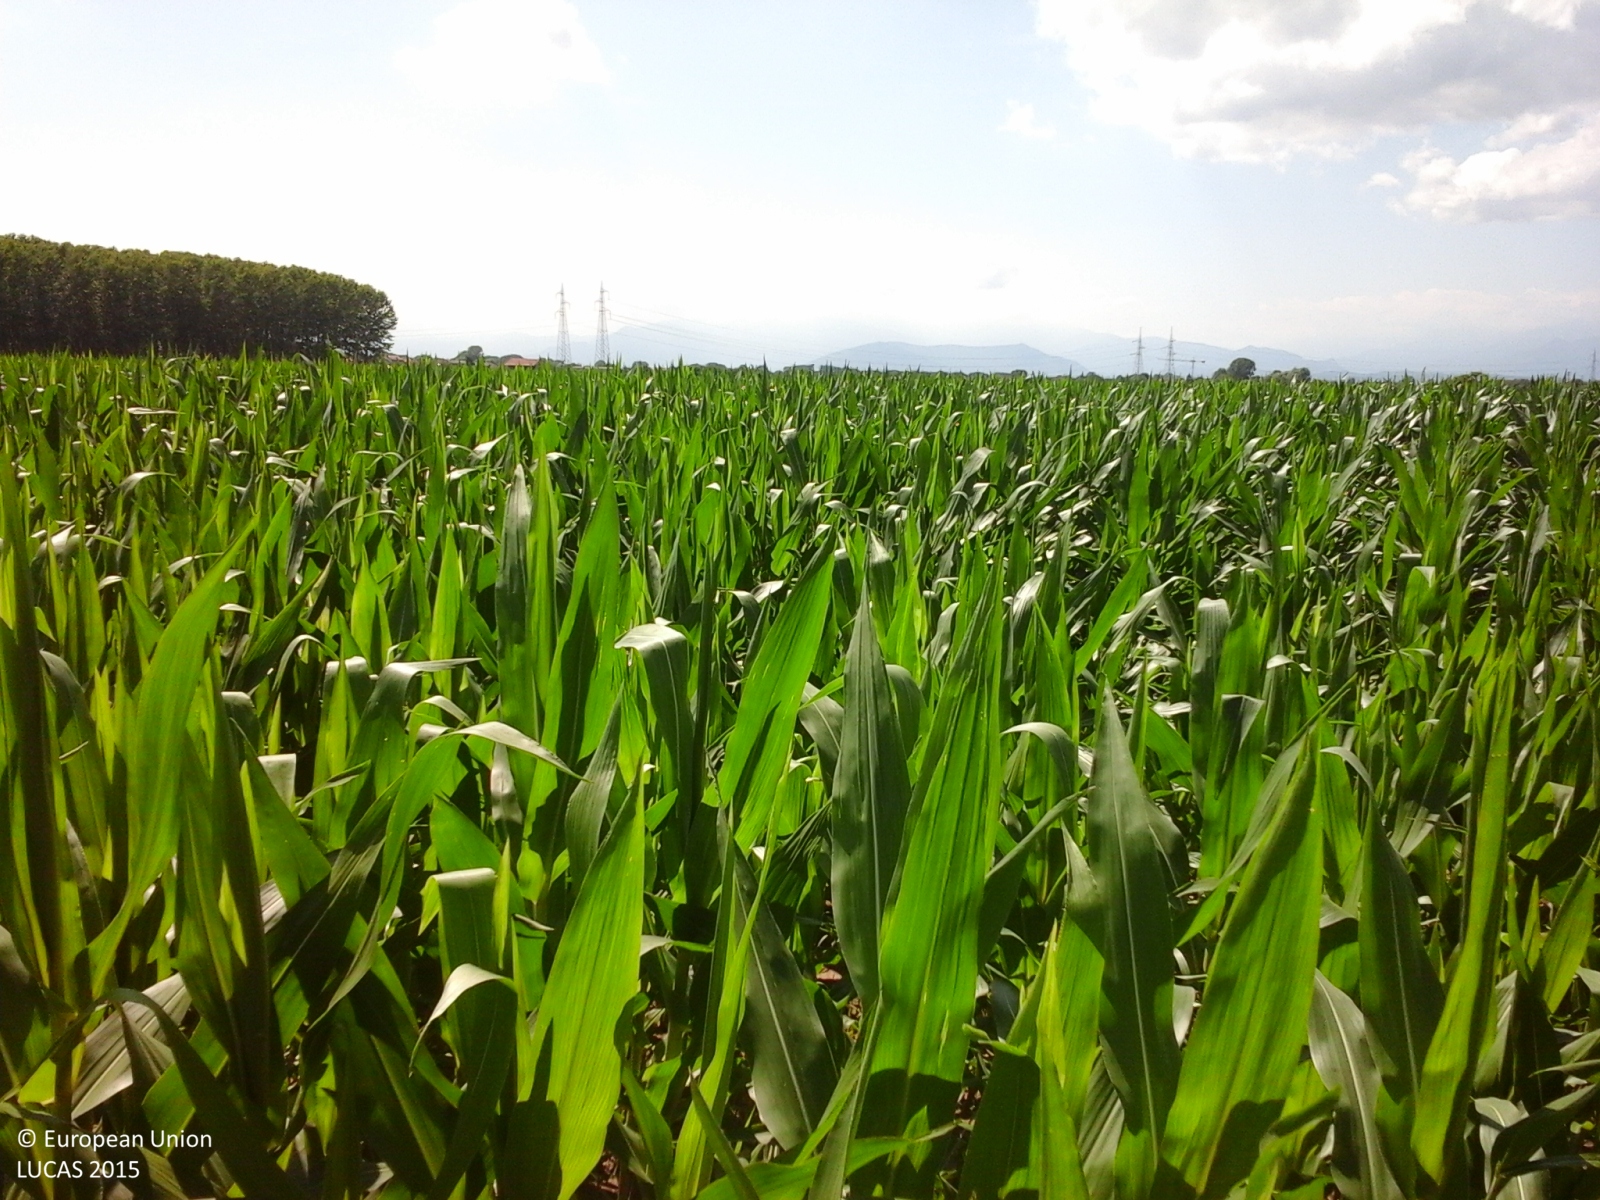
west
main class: Cropland
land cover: Maize
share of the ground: > 75 %
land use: Agriculture (excluding fallow land and kitchen gardens)
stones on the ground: 10 - 25 %
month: June
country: IT
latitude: 44.9572
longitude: 7.7350
